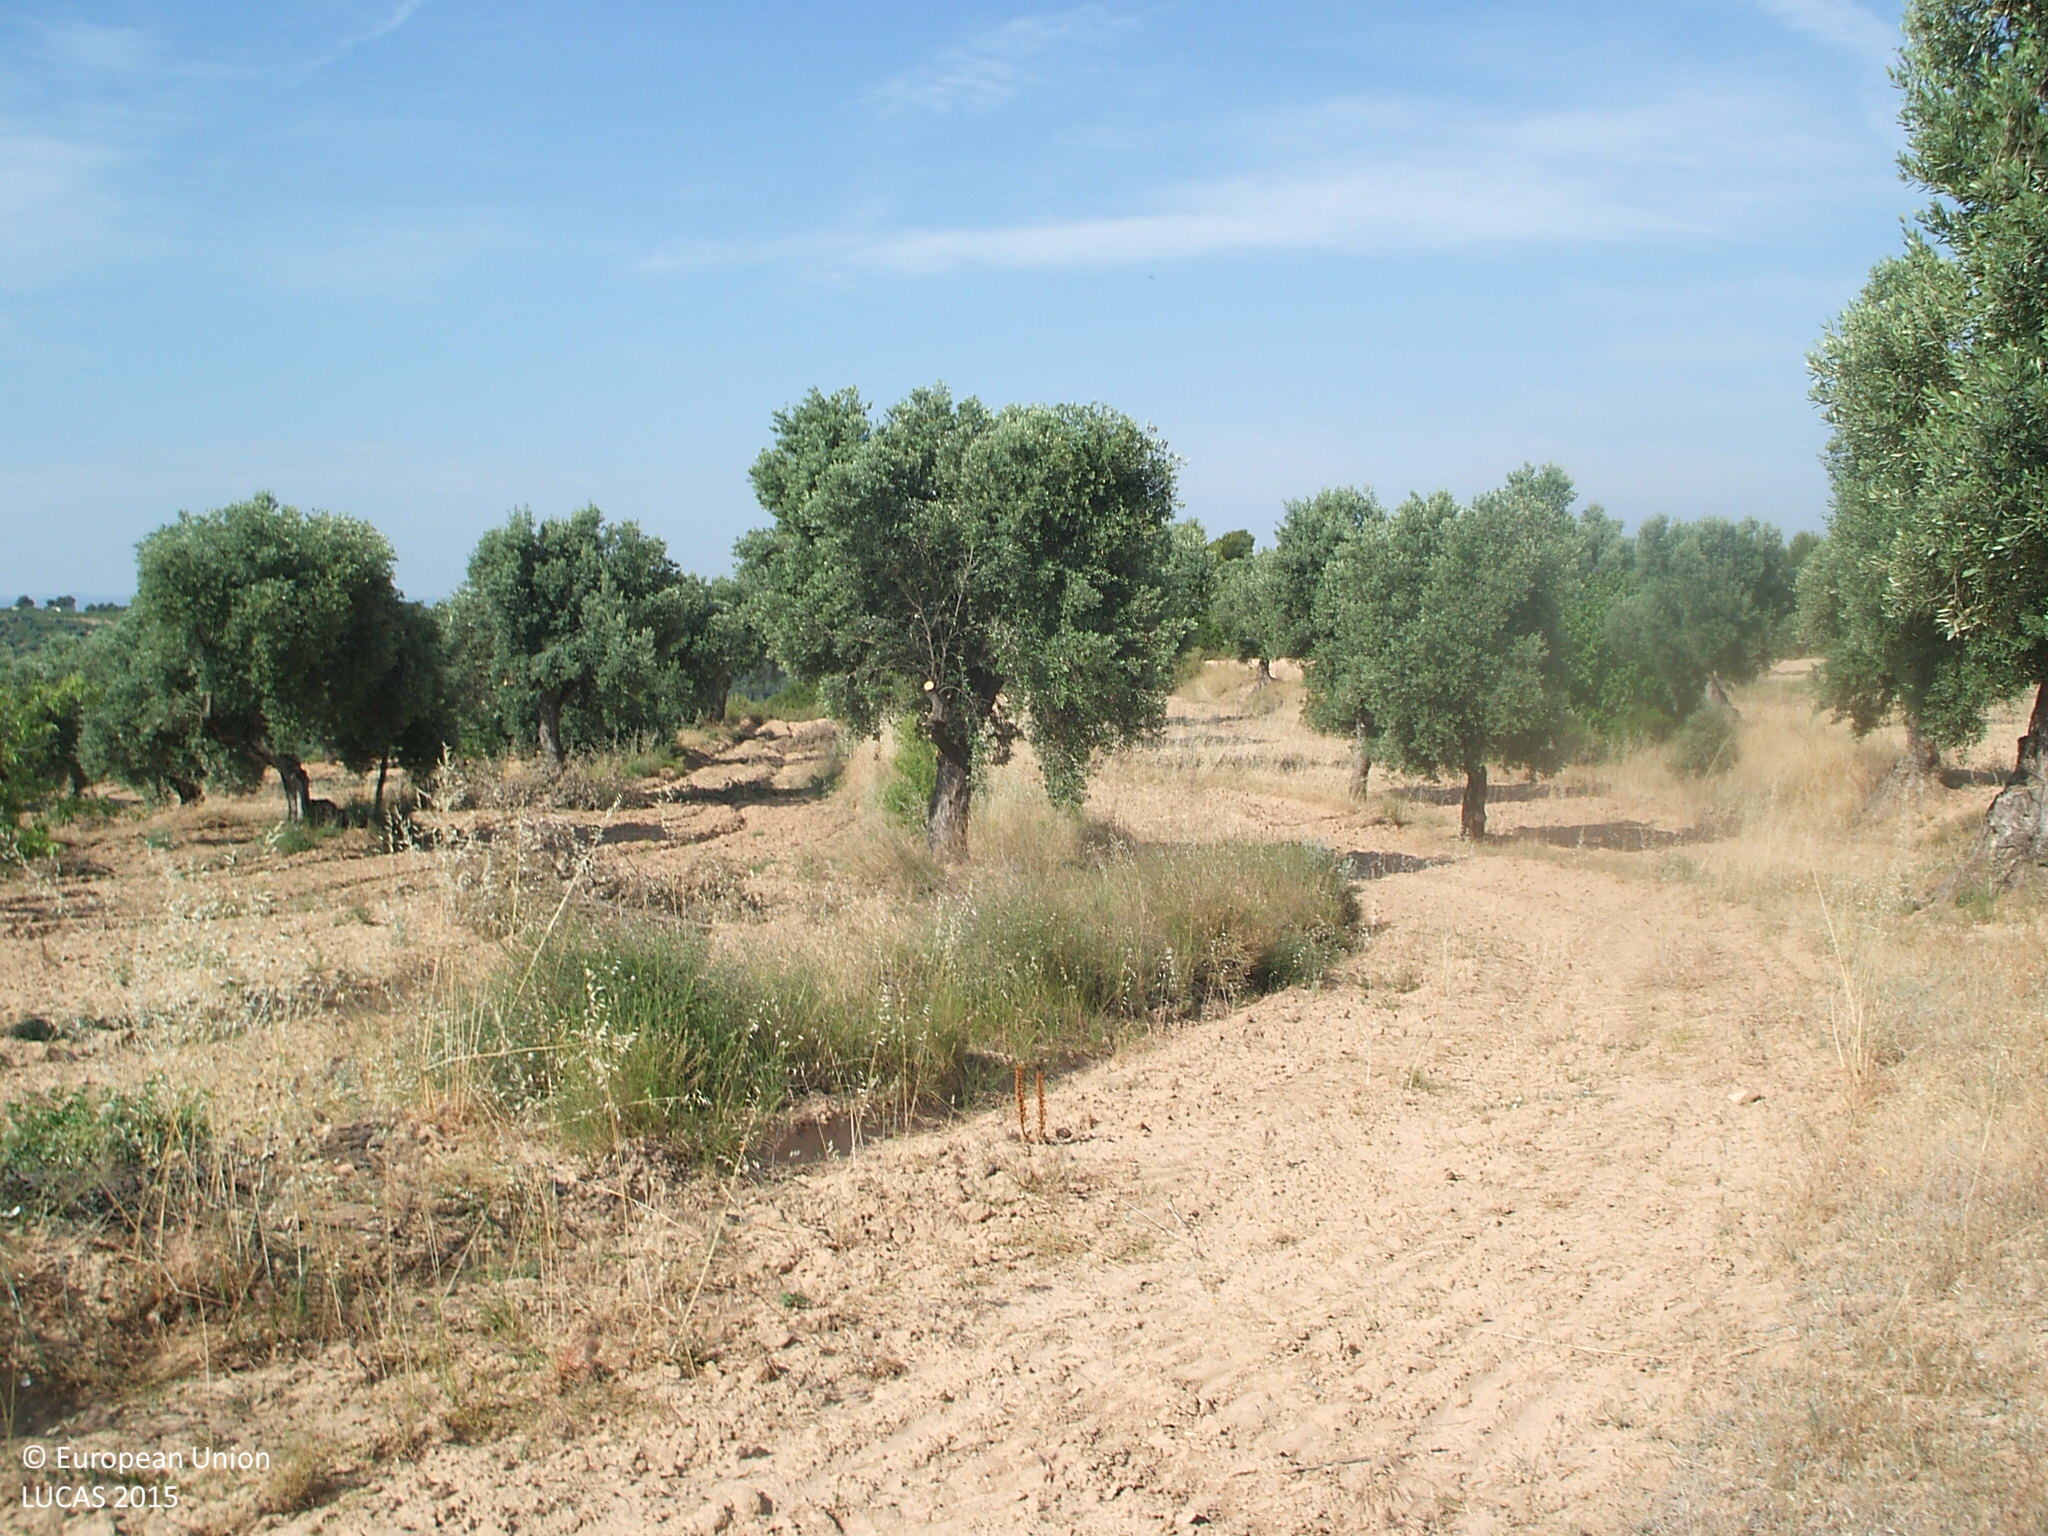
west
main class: Cropland
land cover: Olive groves
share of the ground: 10 - 25 %
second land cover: Other bare soil
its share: > 75 %
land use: Agriculture (excluding fallow land and kitchen gardens)
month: June
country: ES
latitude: 41.0452
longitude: 0.1516
